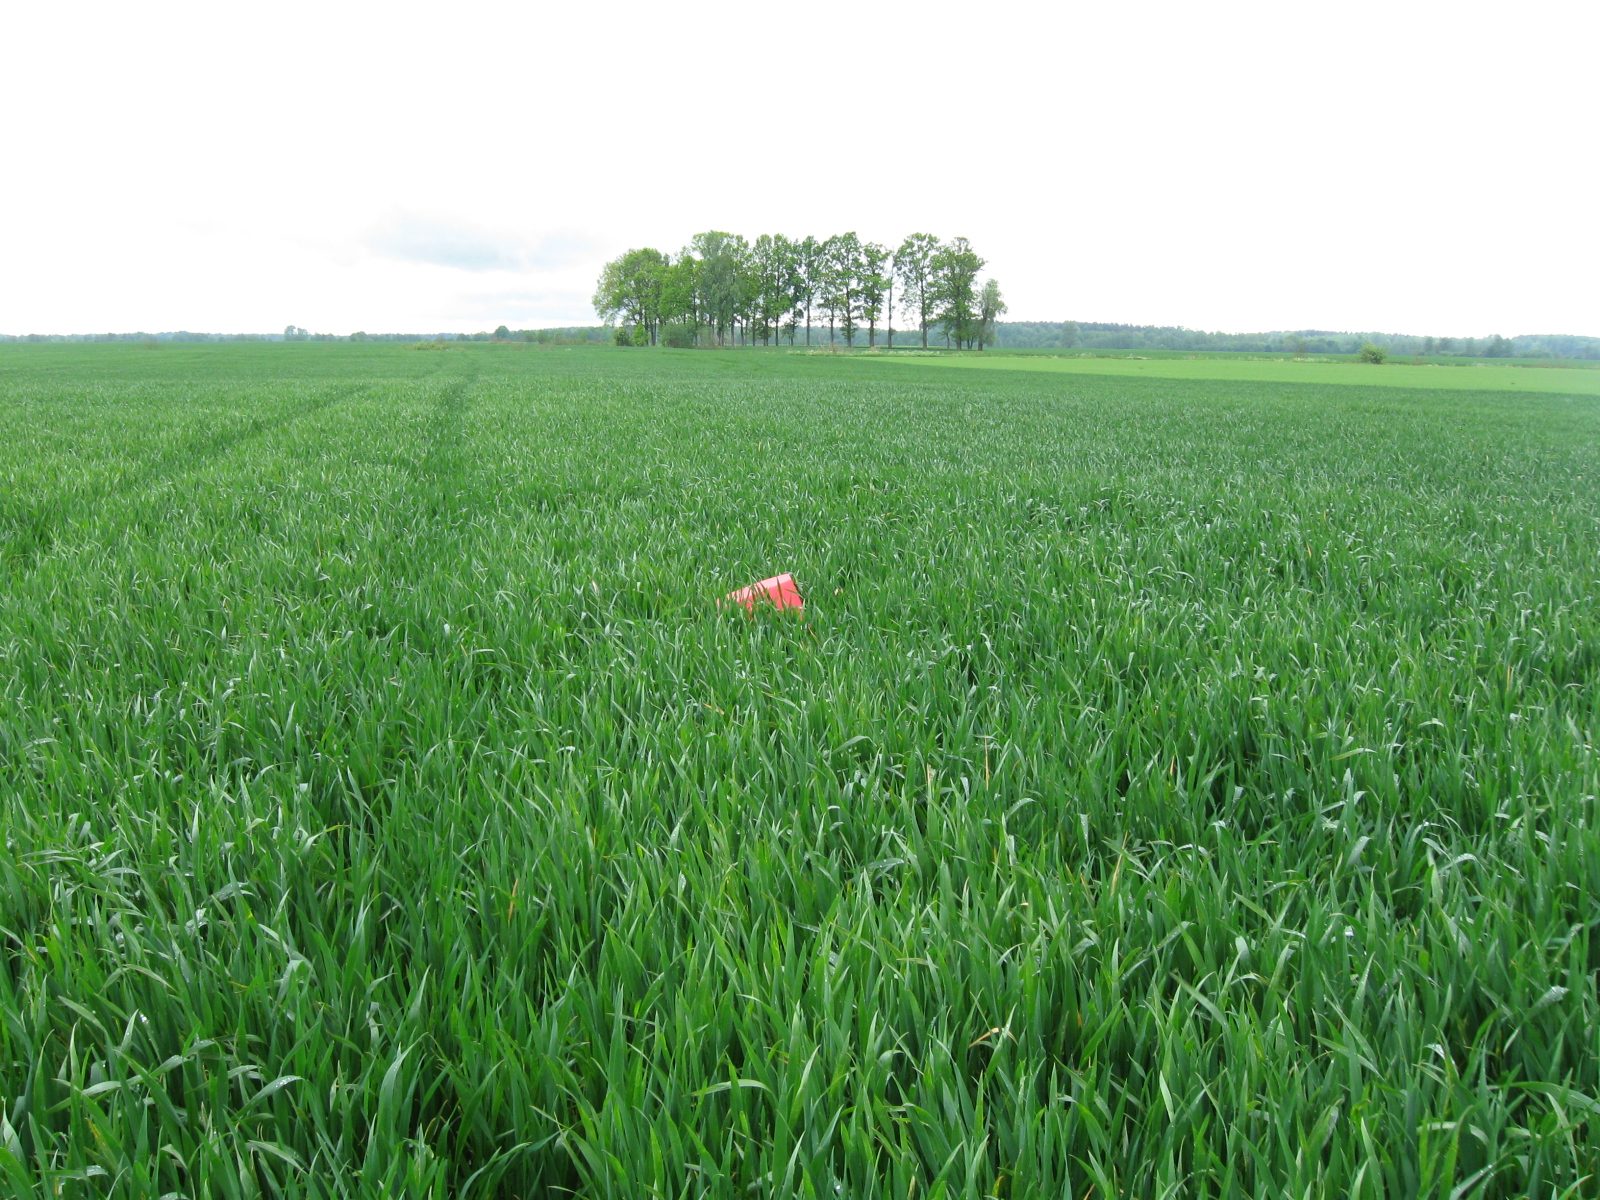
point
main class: Cropland
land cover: Common wheat
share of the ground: > 75 %
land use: Agriculture (excluding fallow land and kitchen gardens)
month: May
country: LT
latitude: 55.0278
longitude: 22.8495
